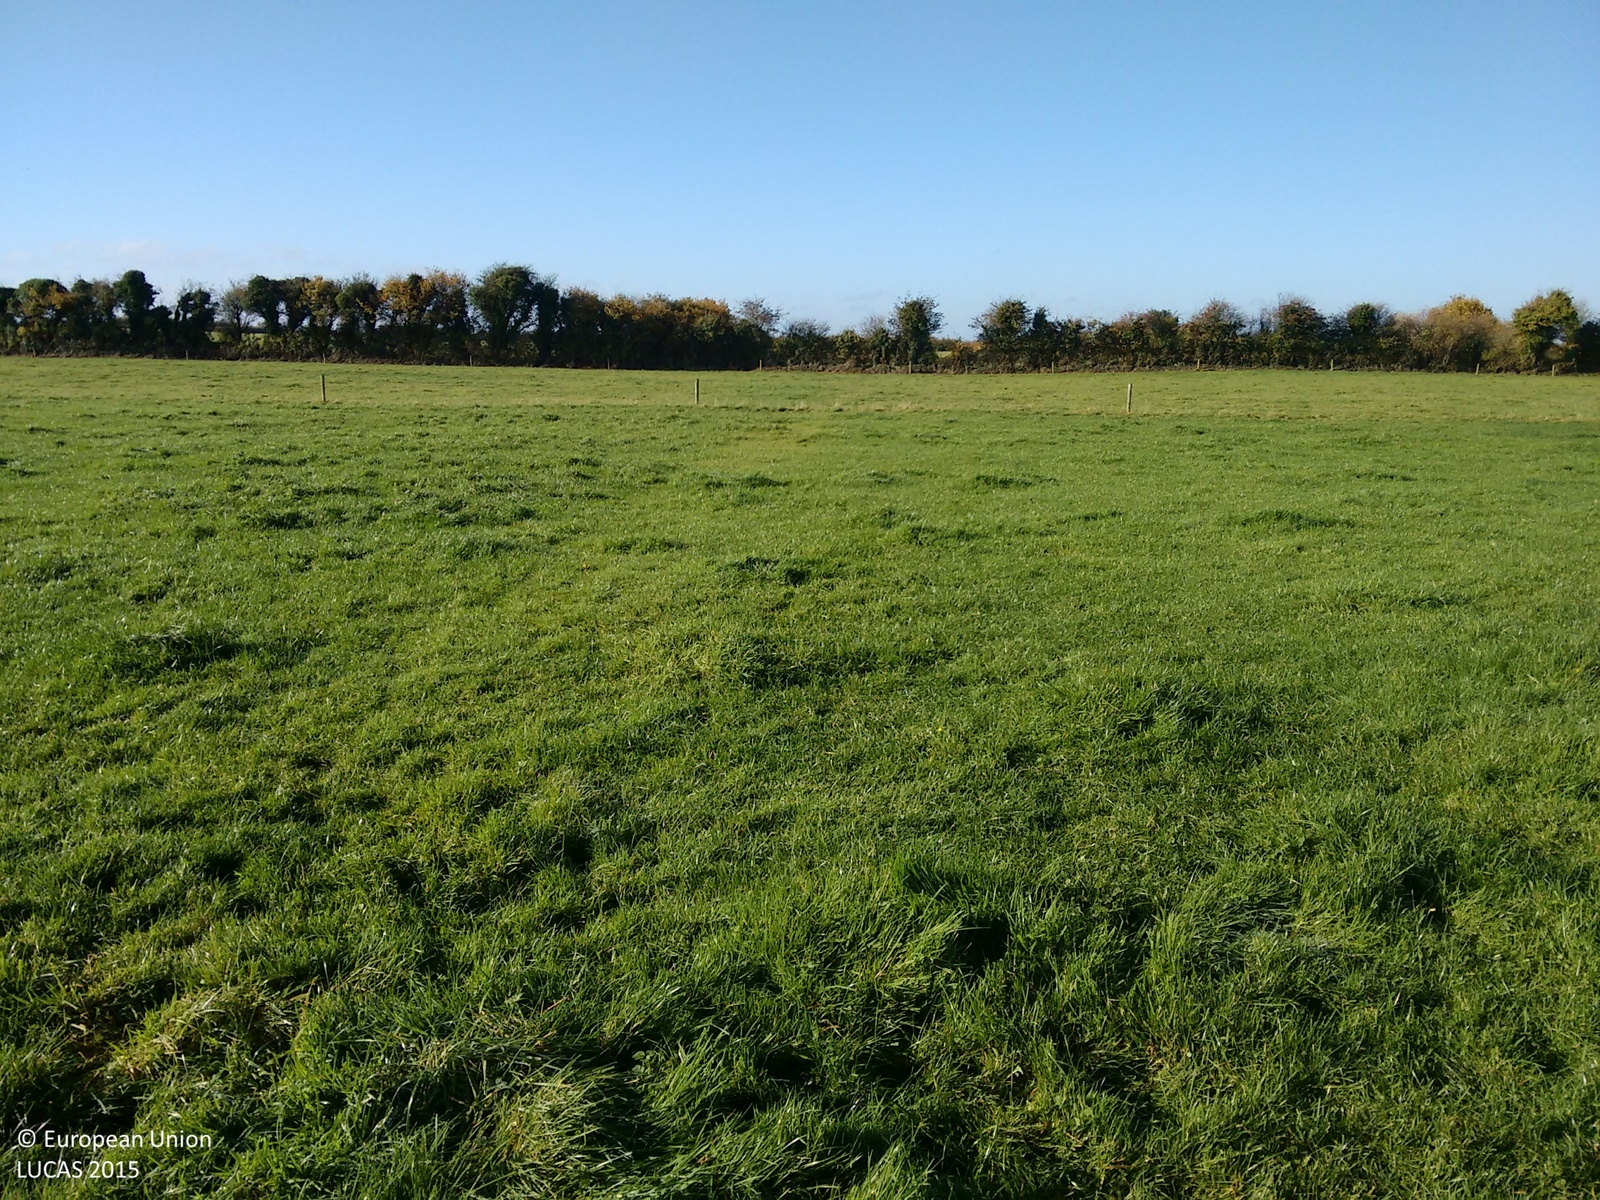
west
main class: Grassland
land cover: Grassland without tree/shrub cover
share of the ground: > 75 %
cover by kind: herbaceous plants 100 %
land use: Agriculture (excluding fallow land and kitchen gardens)
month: October
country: IE
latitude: 53.2855
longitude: -7.5446
